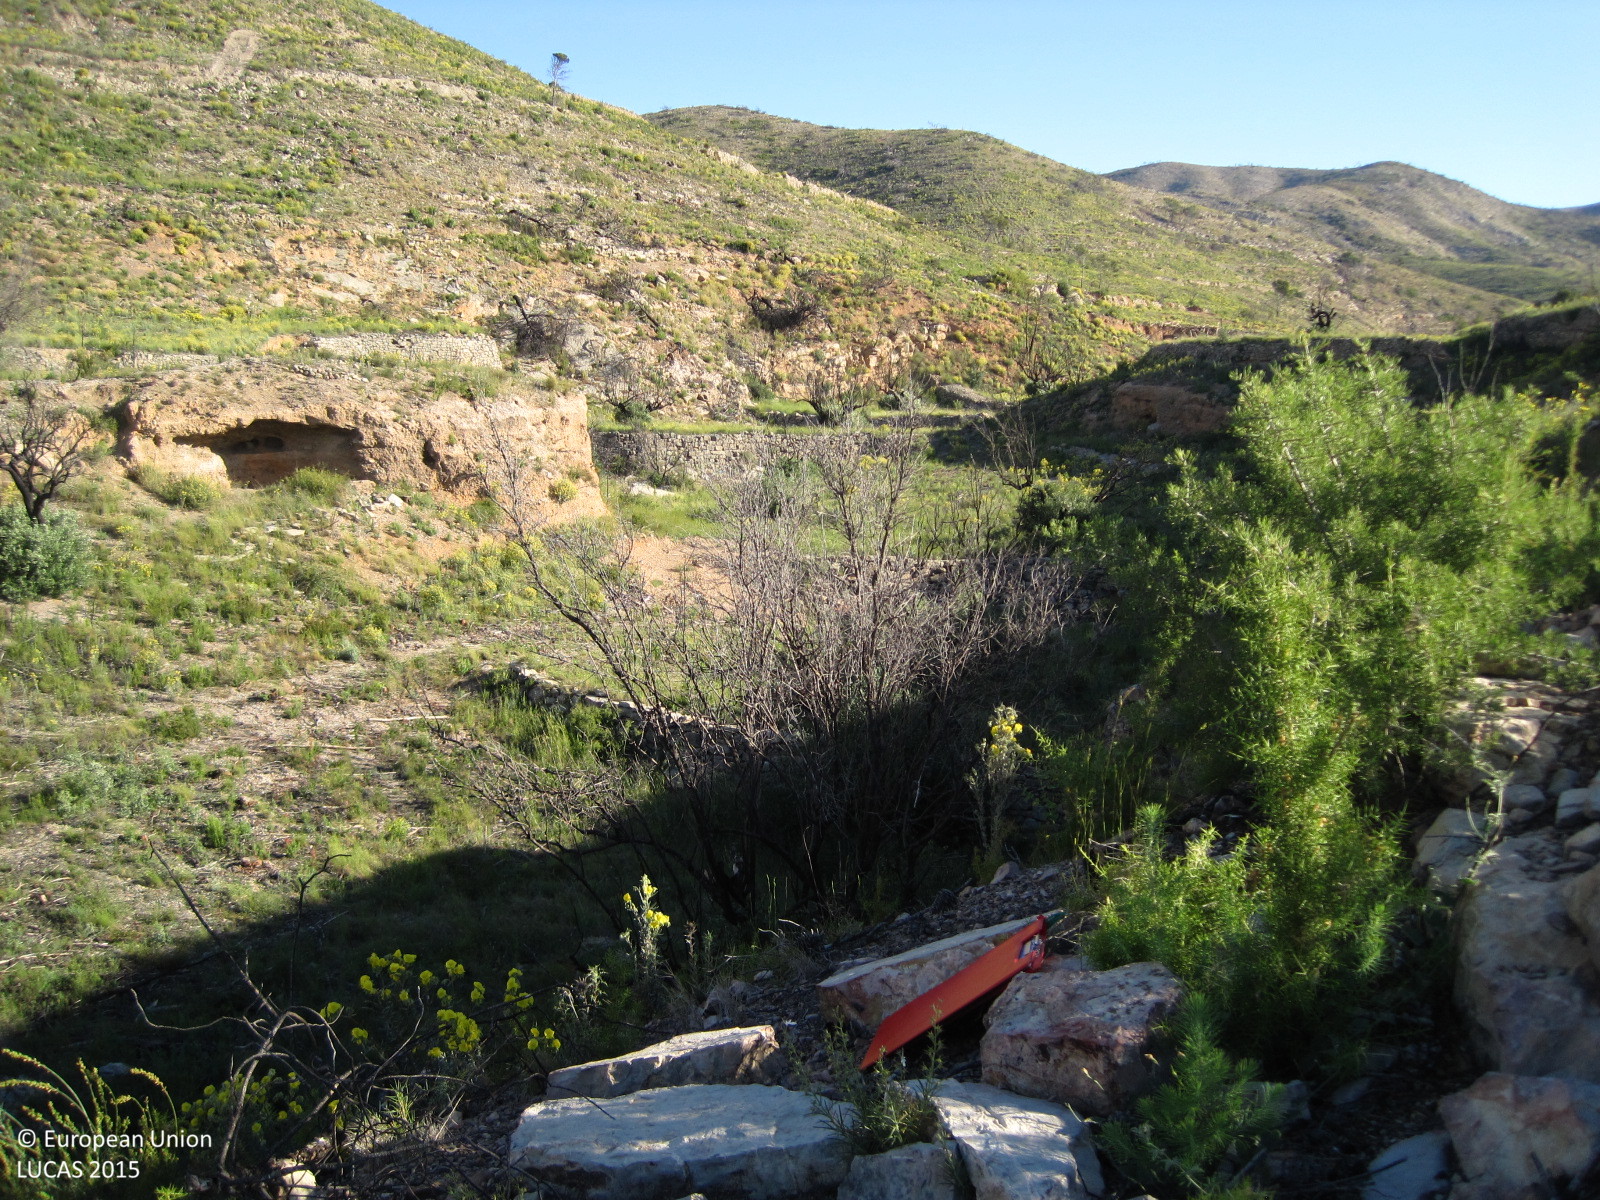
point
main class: Shrubland
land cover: Shrubland without tree cover
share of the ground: 25 - 50 %
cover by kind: shrubs 75 %, herbaceous plants 15 %, consolidated bare surface 5 %, unconsolidated bare surface 5 %
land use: Semi-natural and natural areas not in use
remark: Burnt area
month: May
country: ES
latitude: 39.7554
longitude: -0.6814
